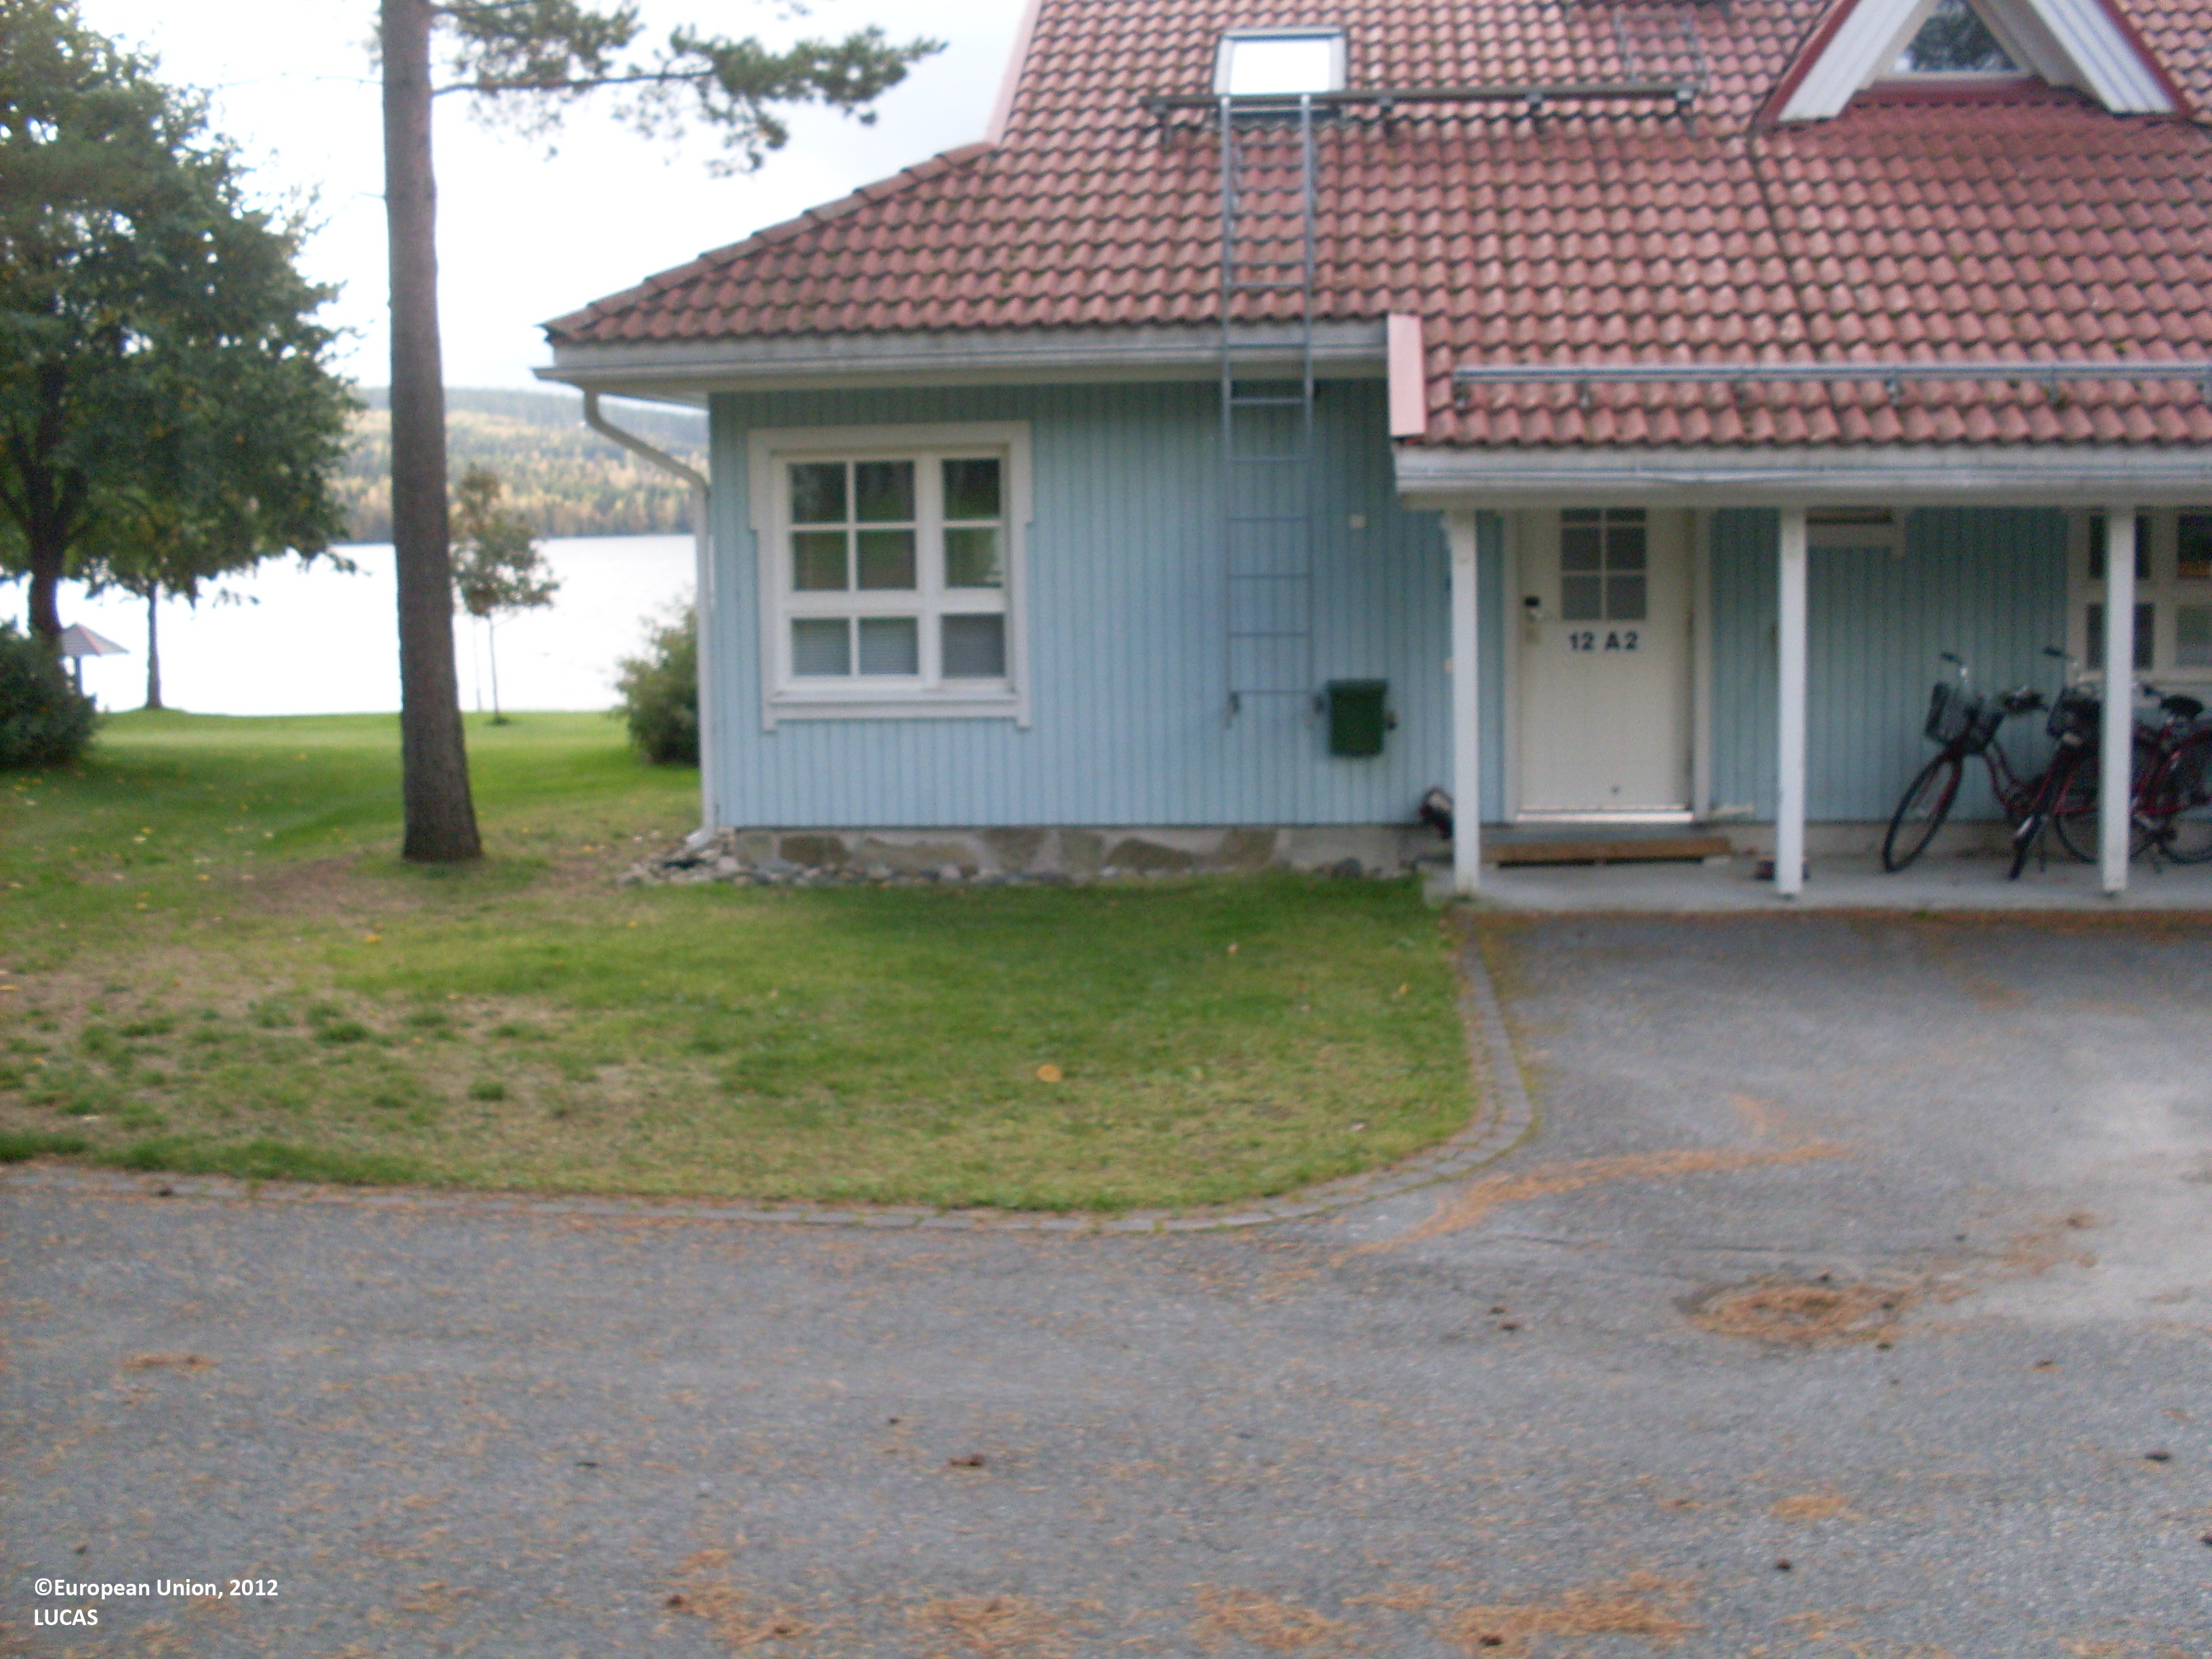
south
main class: Grassland
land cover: Grassland with sparse tree/shrub cover
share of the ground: > 75 %
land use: Residential
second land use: Holiday camps
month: September
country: FI
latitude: 64.1468
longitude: 28.2385
